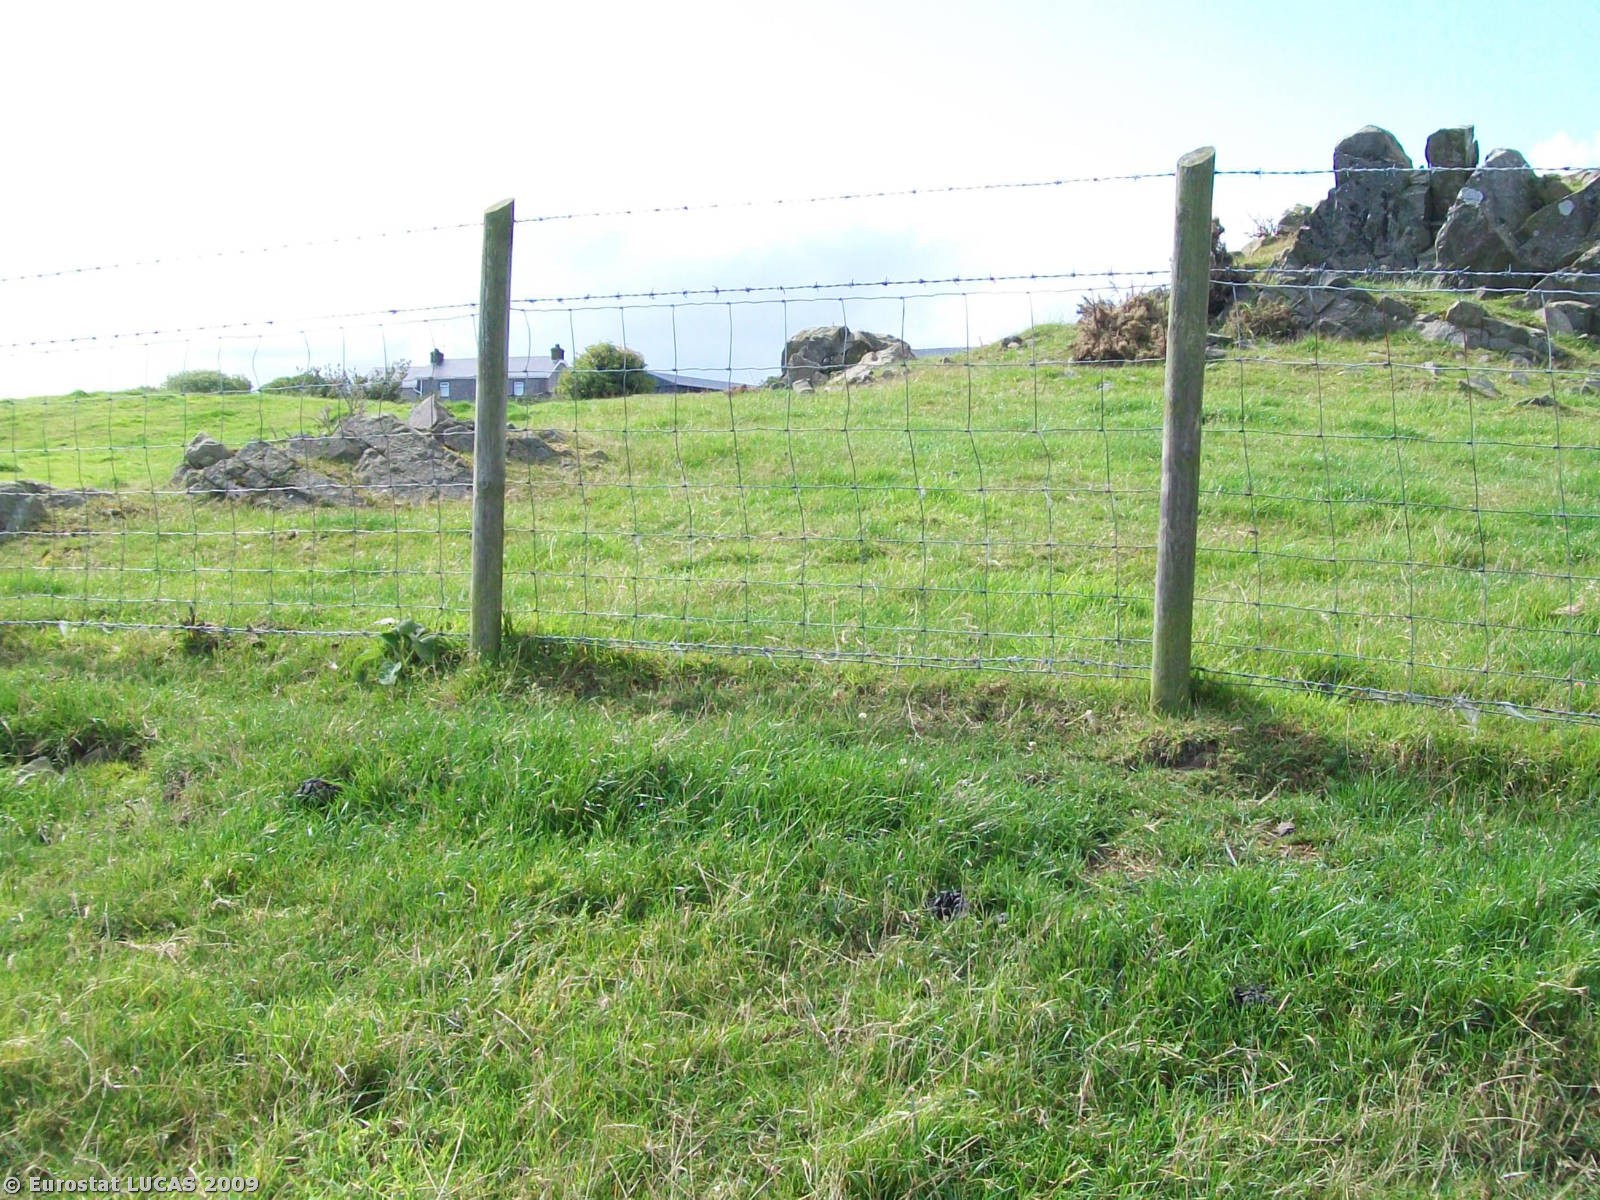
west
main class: Grassland
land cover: Grassland without tree/shrub cover
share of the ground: > 75 %
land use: Agriculture (excluding fallow land and kitchen gardens)
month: August
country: GB
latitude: 54.4639
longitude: -5.6677
